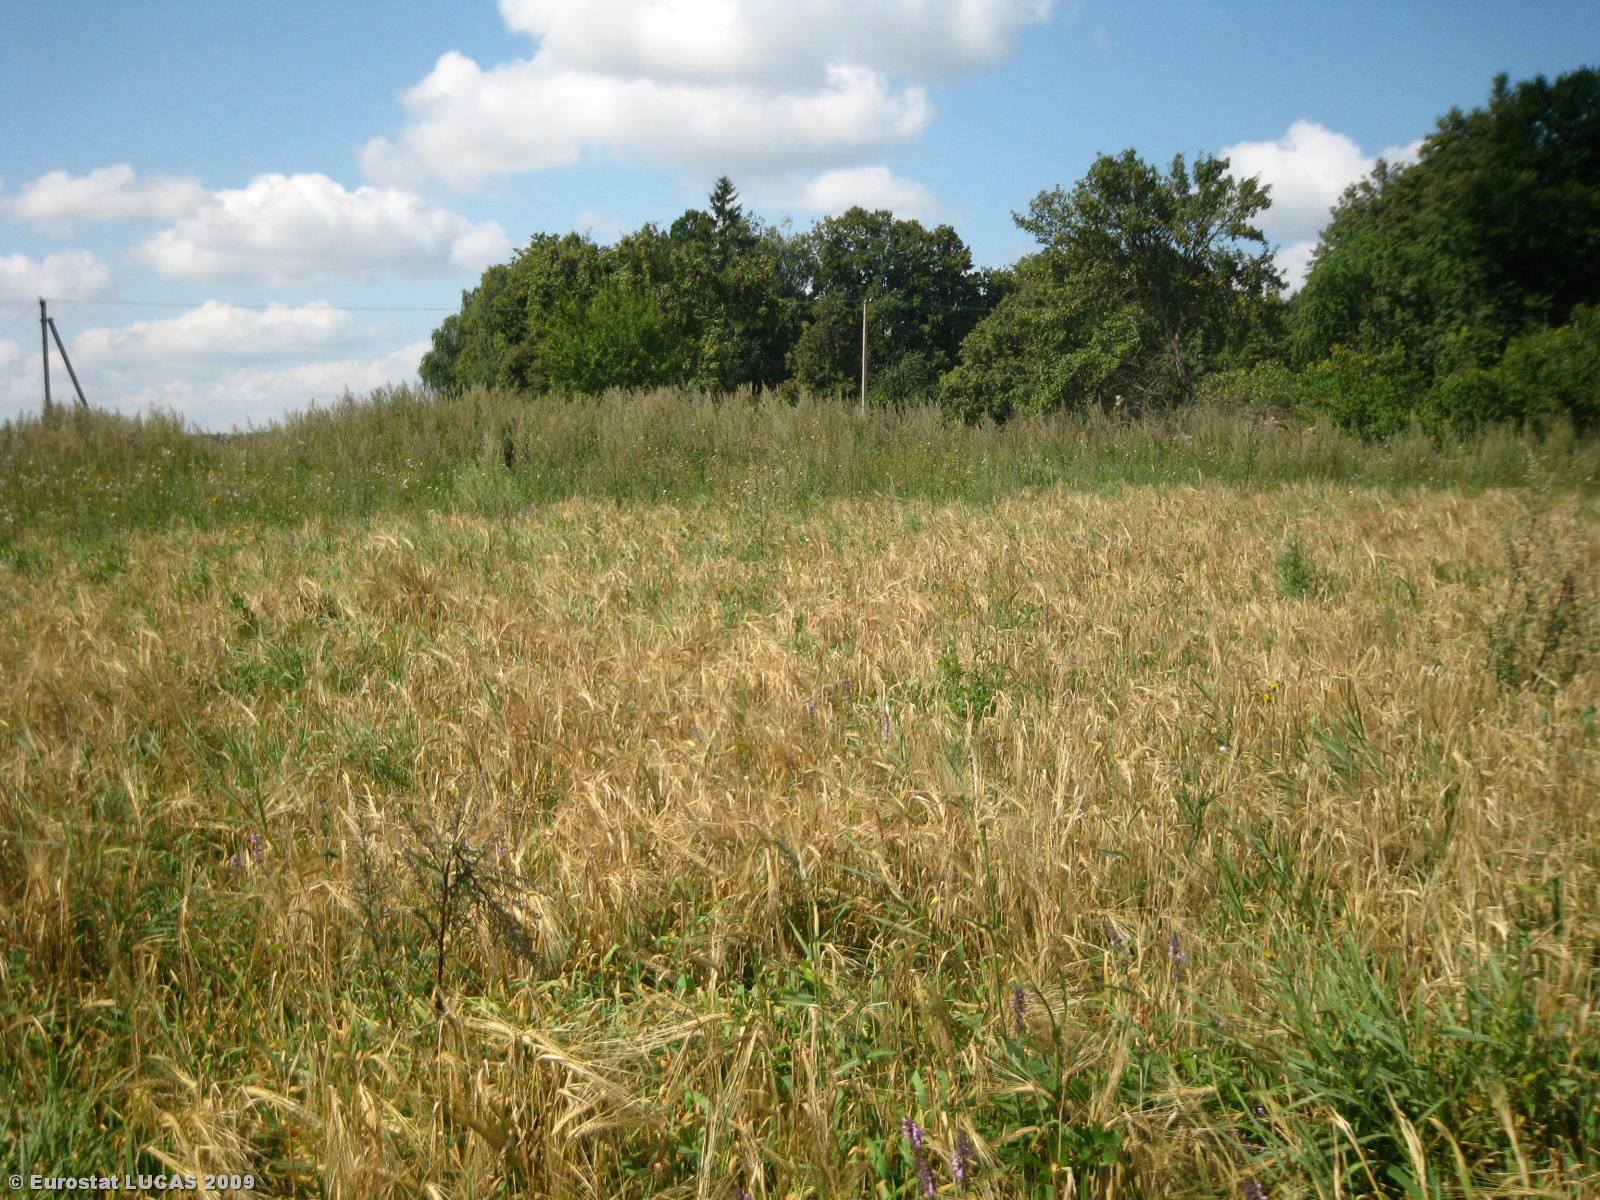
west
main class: Cropland
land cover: Barley
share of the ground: > 75 %
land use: Agriculture (excluding fallow land and kitchen gardens)
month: August
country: LT
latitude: 55.1921
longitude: 23.7031
